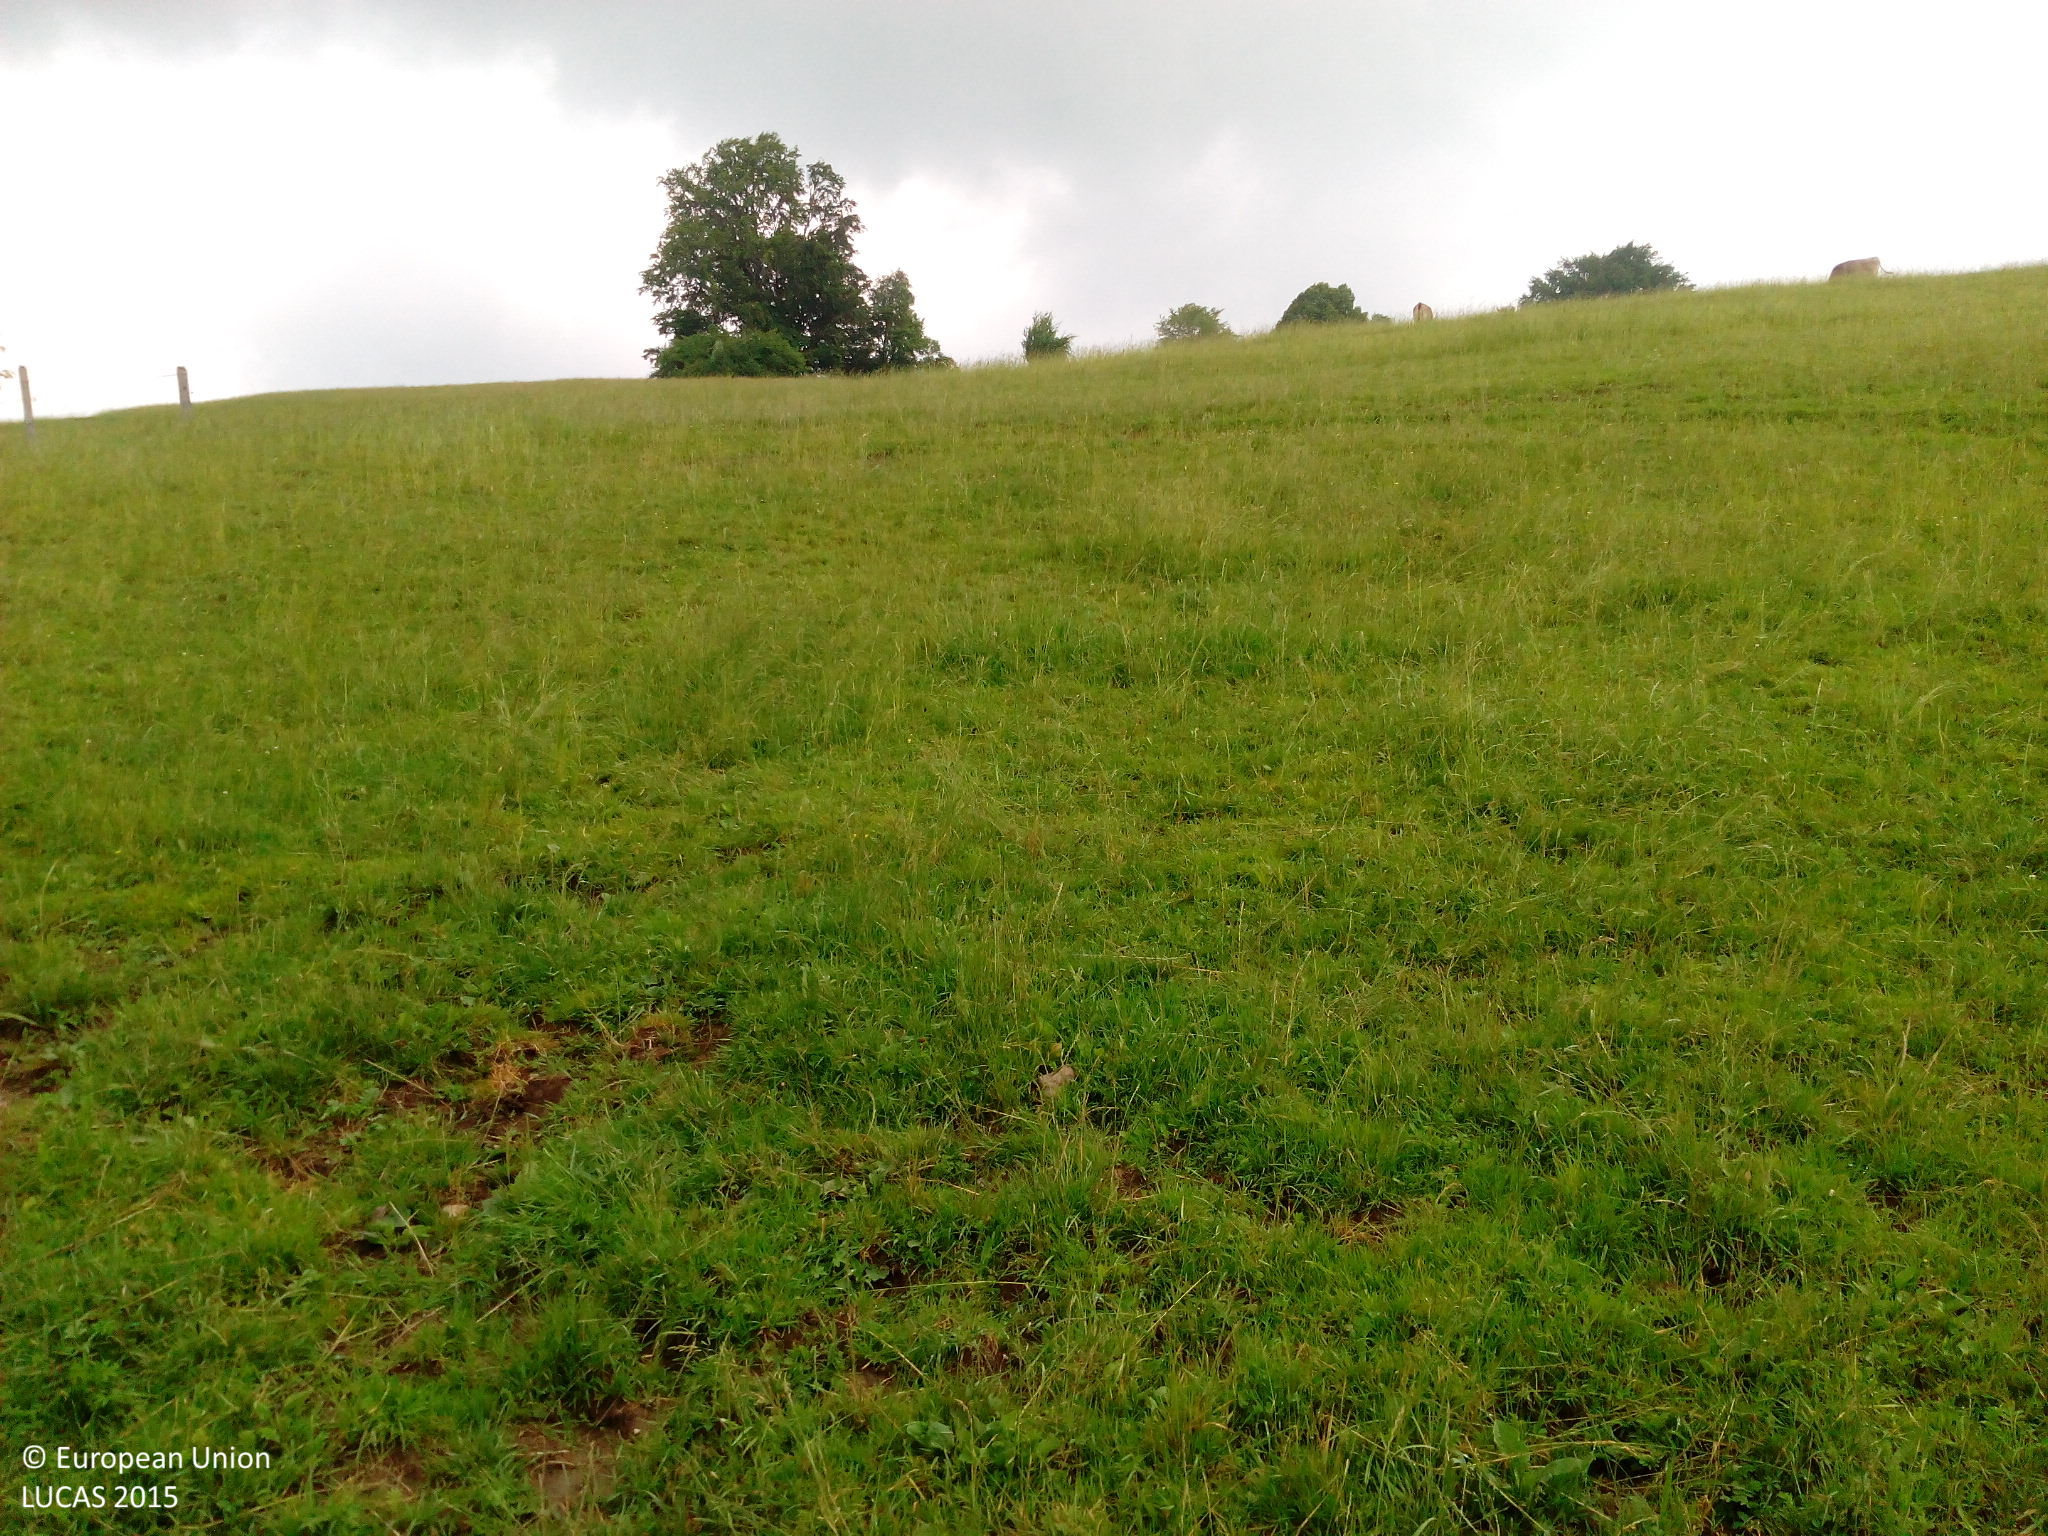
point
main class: Grassland
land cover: Grassland without tree/shrub cover
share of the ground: > 75 %
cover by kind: herbaceous plants 100 %
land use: Agriculture (excluding fallow land and kitchen gardens)
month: June
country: DE
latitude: 47.7004
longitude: 10.5193
